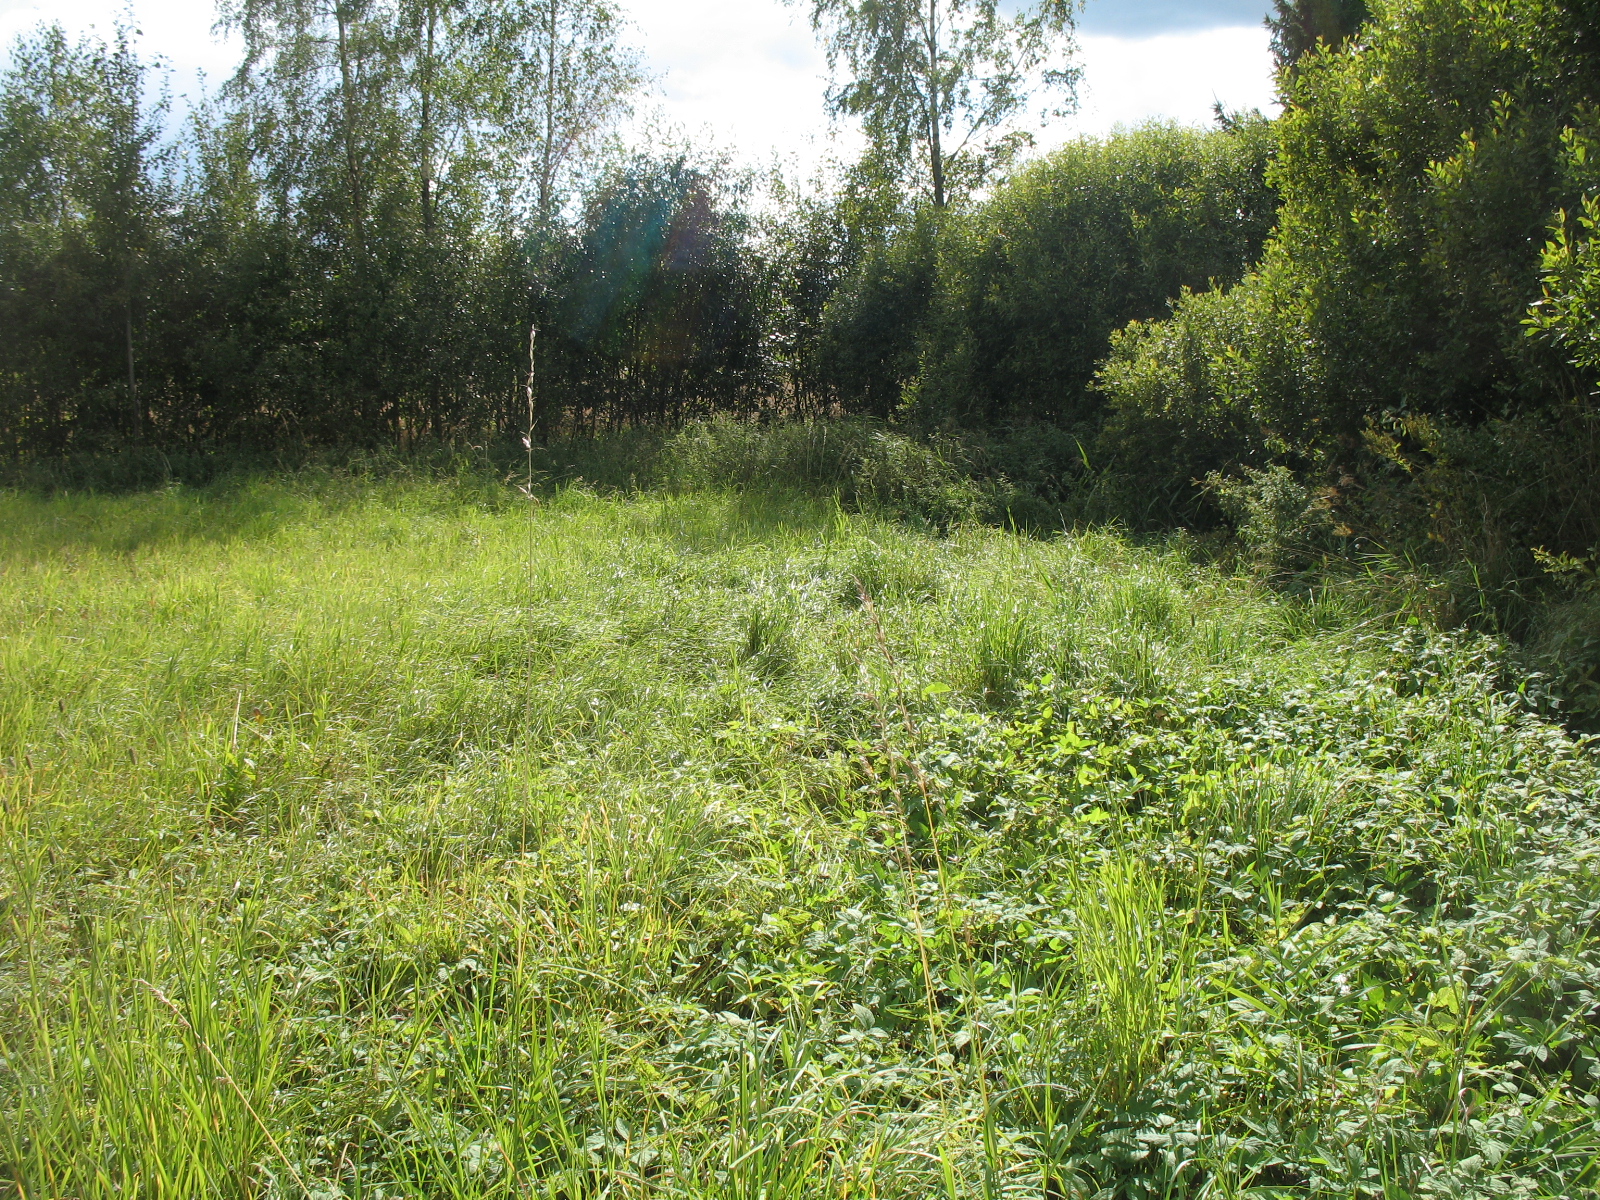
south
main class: Grassland
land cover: Grassland without tree/shrub cover
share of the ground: > 75 %
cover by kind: herbaceous plants 100 %
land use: Agriculture (excluding fallow land and kitchen gardens)
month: September
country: LV
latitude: 56.1554
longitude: 25.4966
